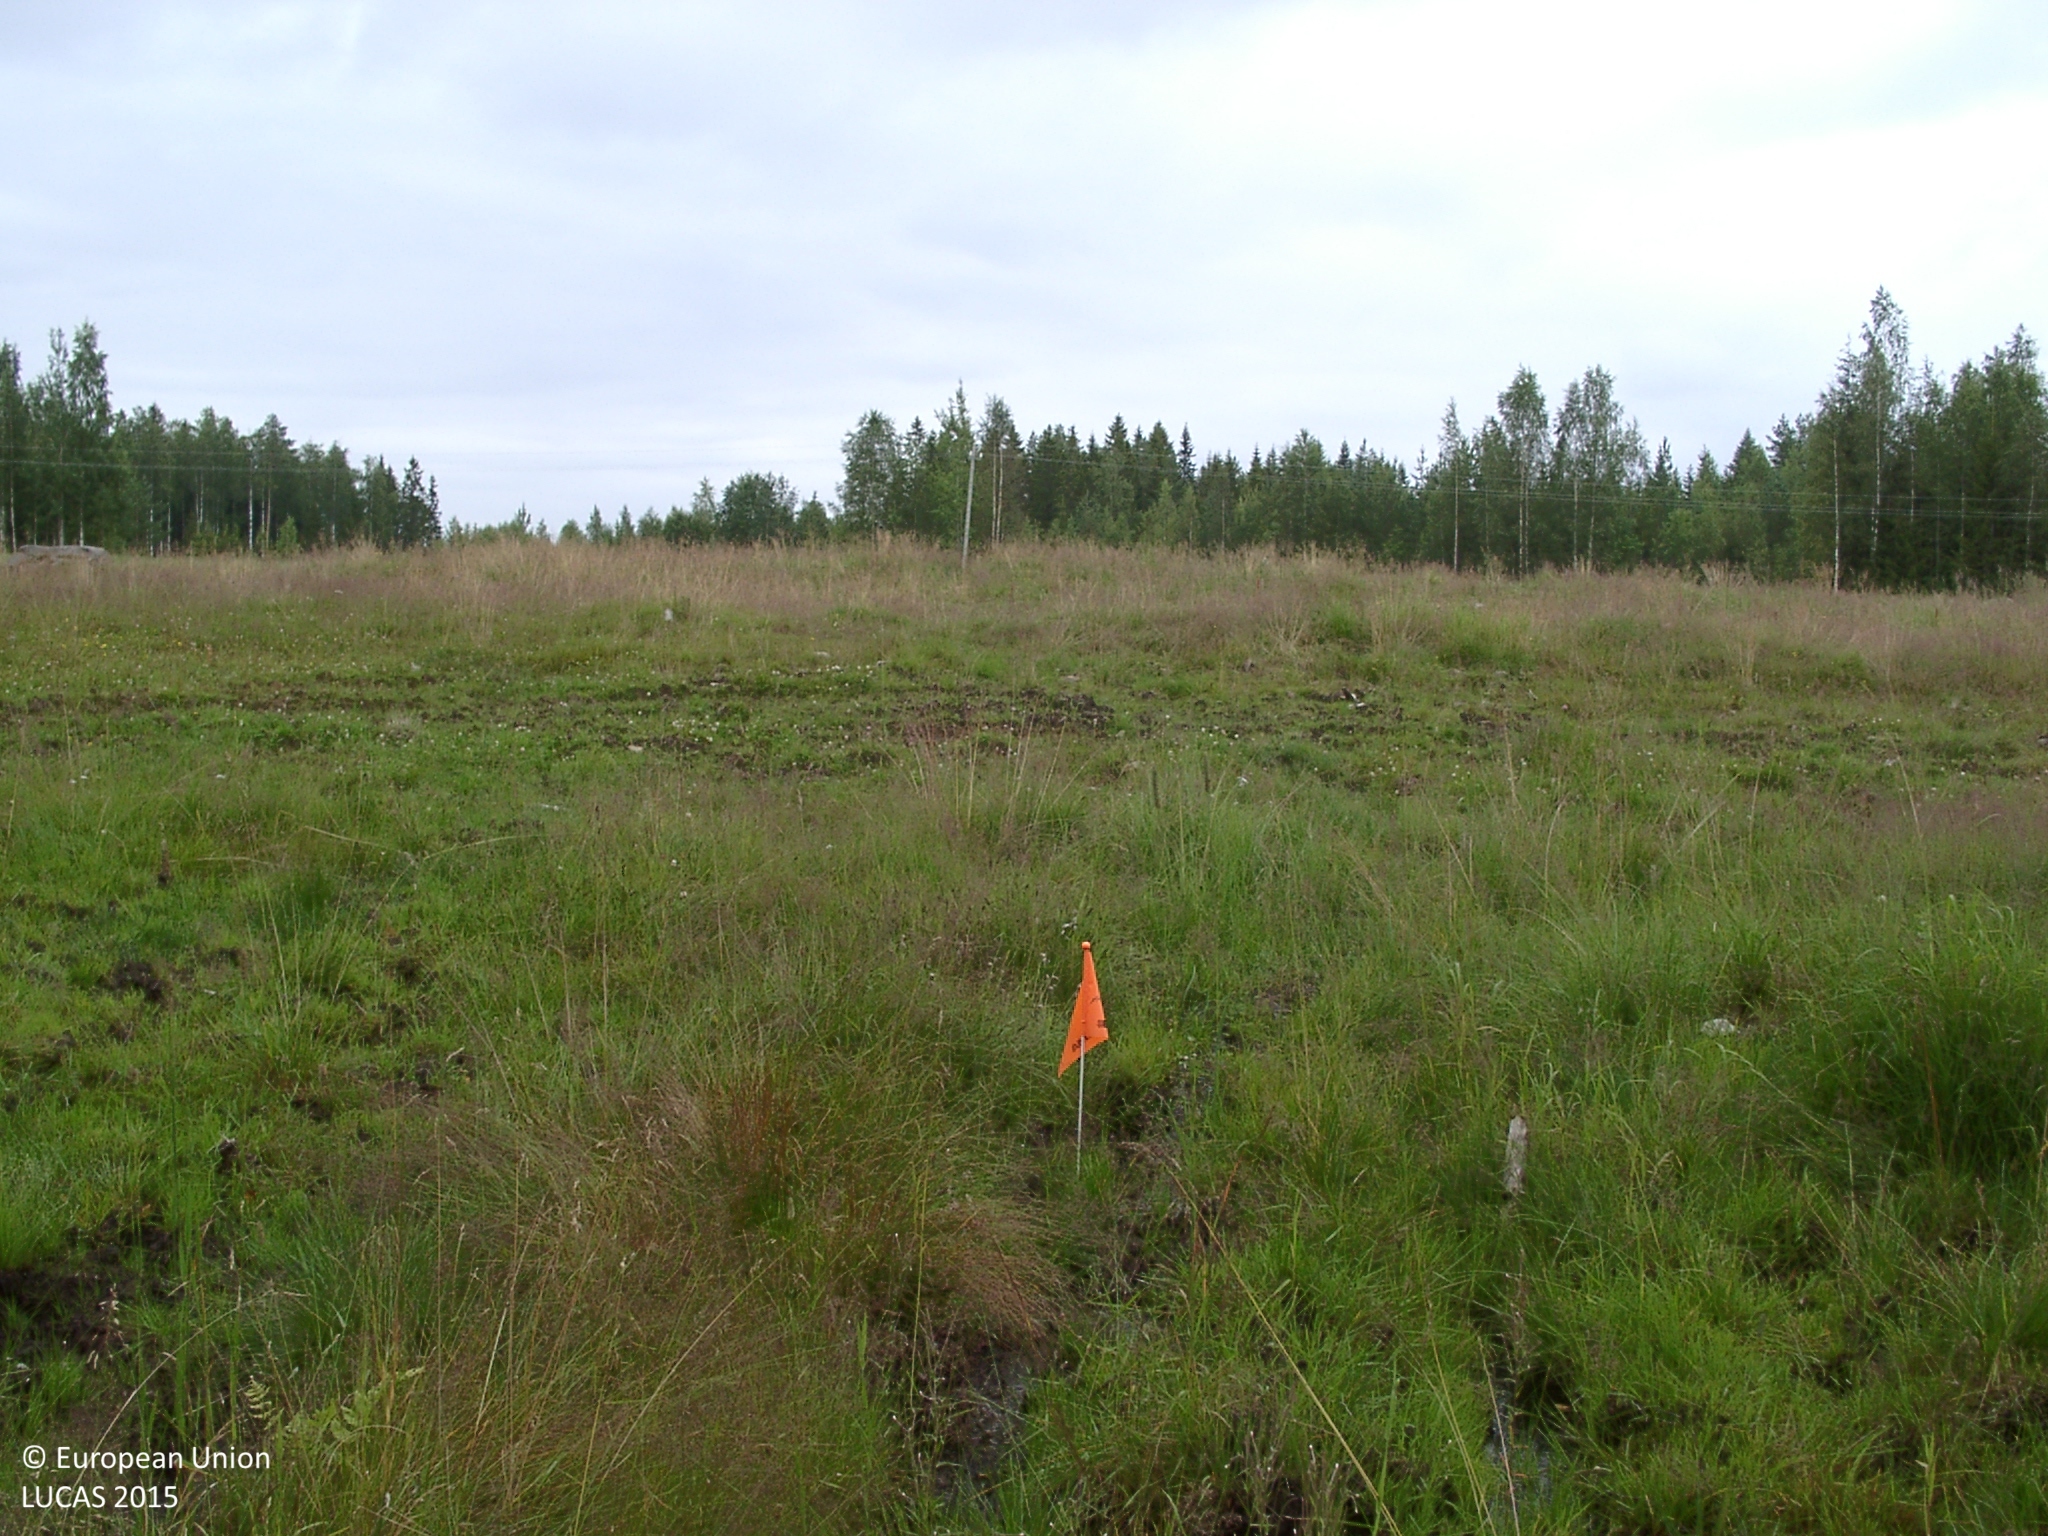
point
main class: Grassland
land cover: Grassland without tree/shrub cover
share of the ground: > 75 %
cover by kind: herbaceous plants 90 %, unconsolidated bare surface 10 %
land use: Agriculture (excluding fallow land and kitchen gardens)
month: August
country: FI
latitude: 62.8479
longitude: 24.6437
